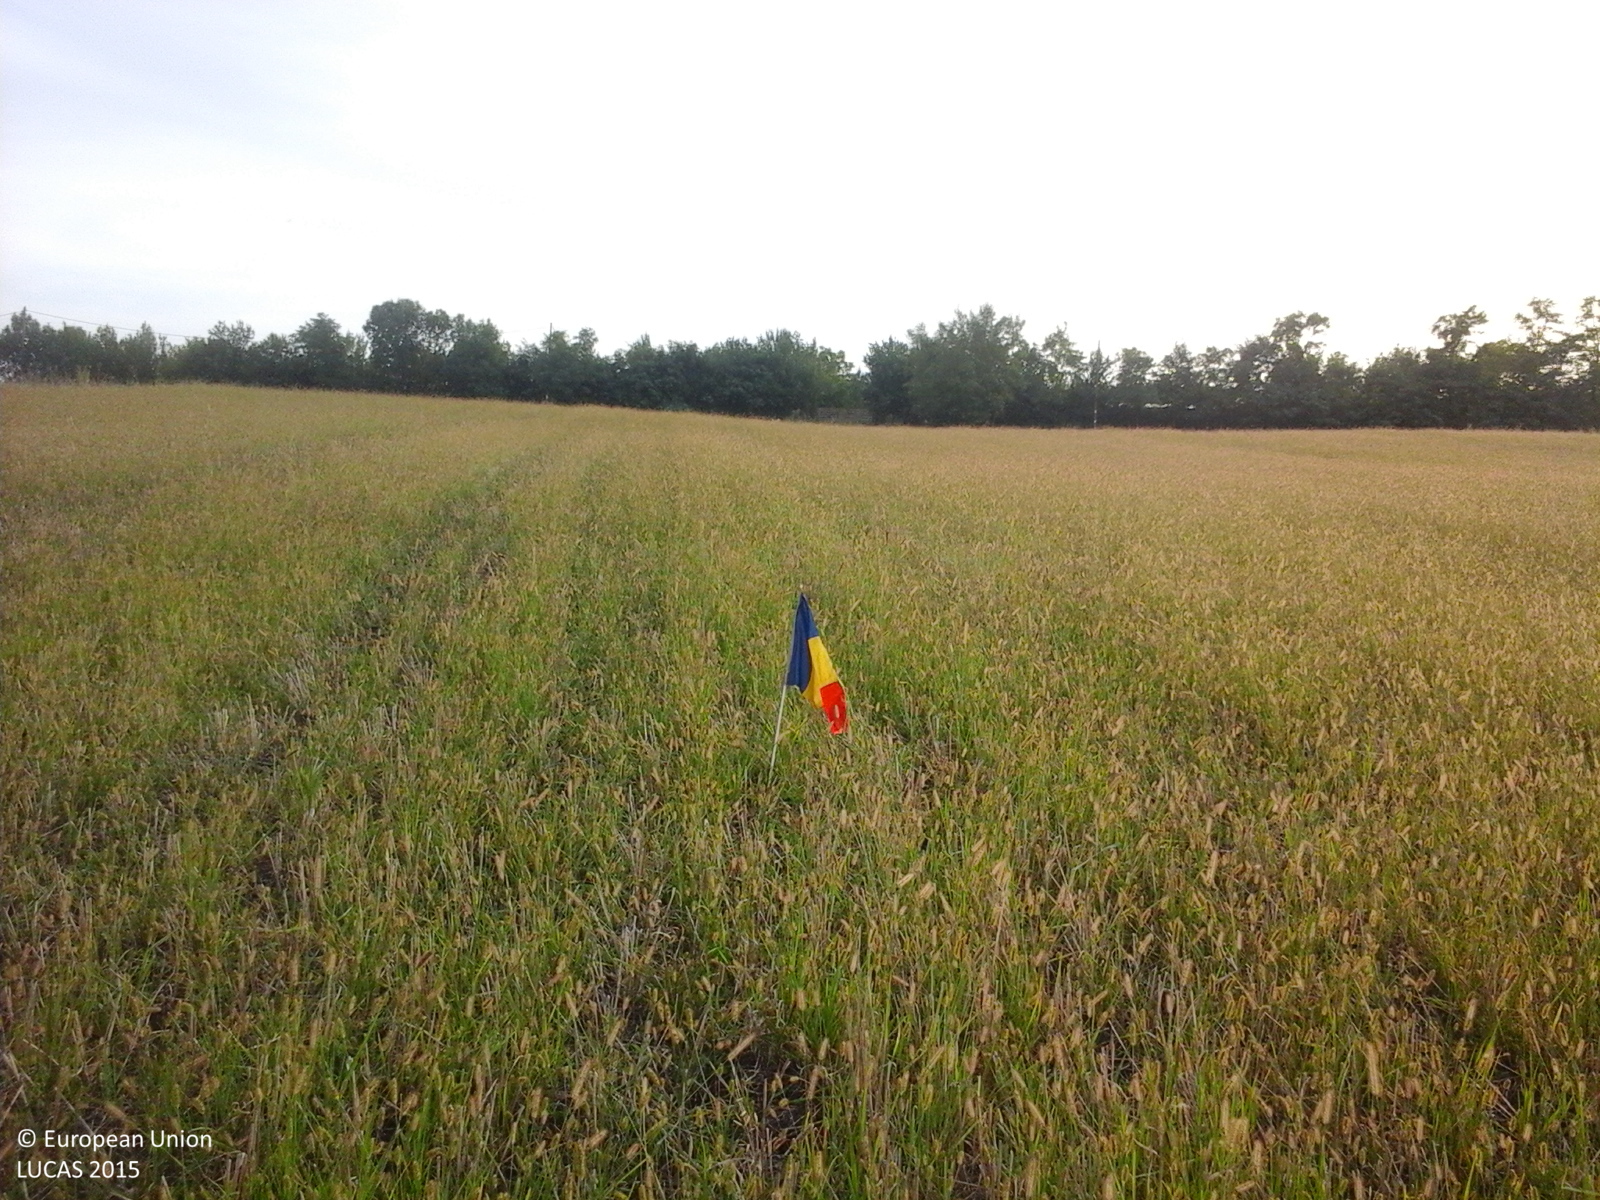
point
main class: Grassland
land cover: Spontaneously vegetated surfaces
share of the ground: > 75 %
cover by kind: herbaceous plants 100 %
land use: Fallow land
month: September
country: RO
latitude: 46.7699
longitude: 24.0522
